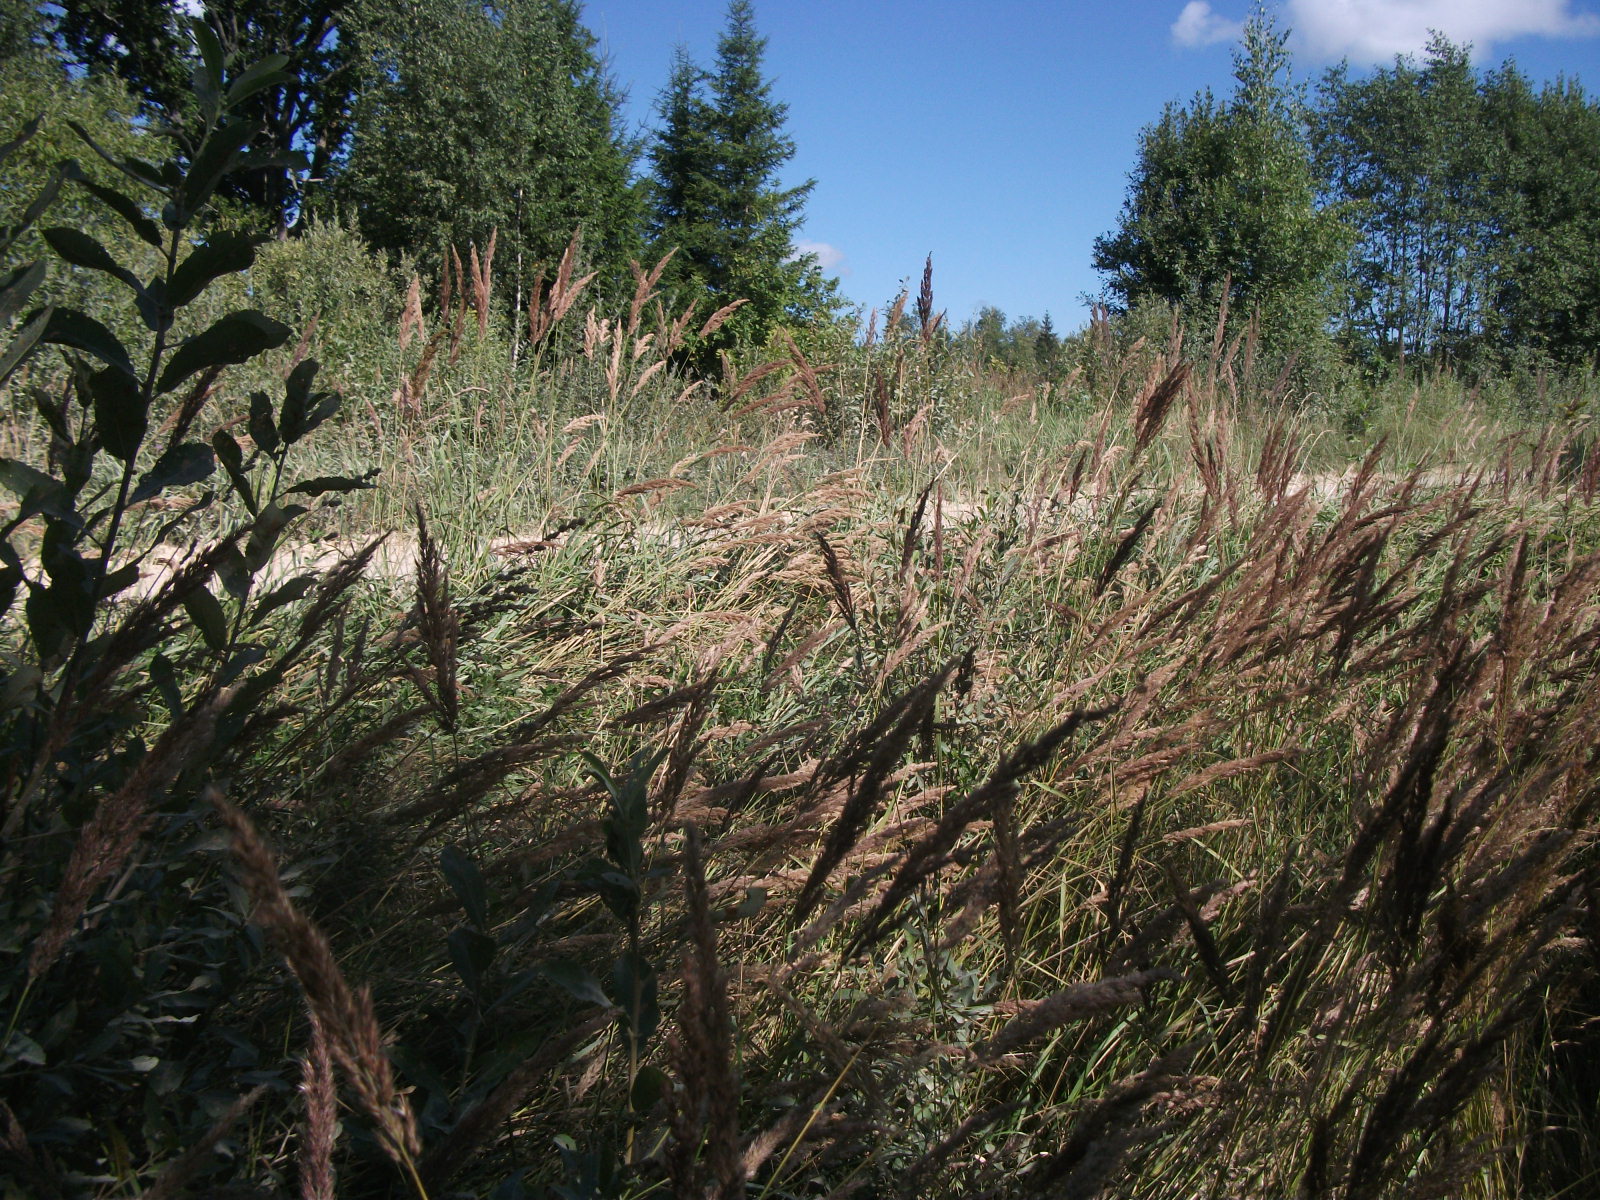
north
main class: Woodland
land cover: Broadleaved woodland
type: non-riverine alder, birch or aspen forest
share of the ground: 50 - 75 %
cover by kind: broadleaved forest trees 50 %, shrubs 30 %, herbaceous plants 20 %
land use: Semi-natural and natural areas not in use
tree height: > 5 m
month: August
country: LV
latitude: 56.6122
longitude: 26.2545
